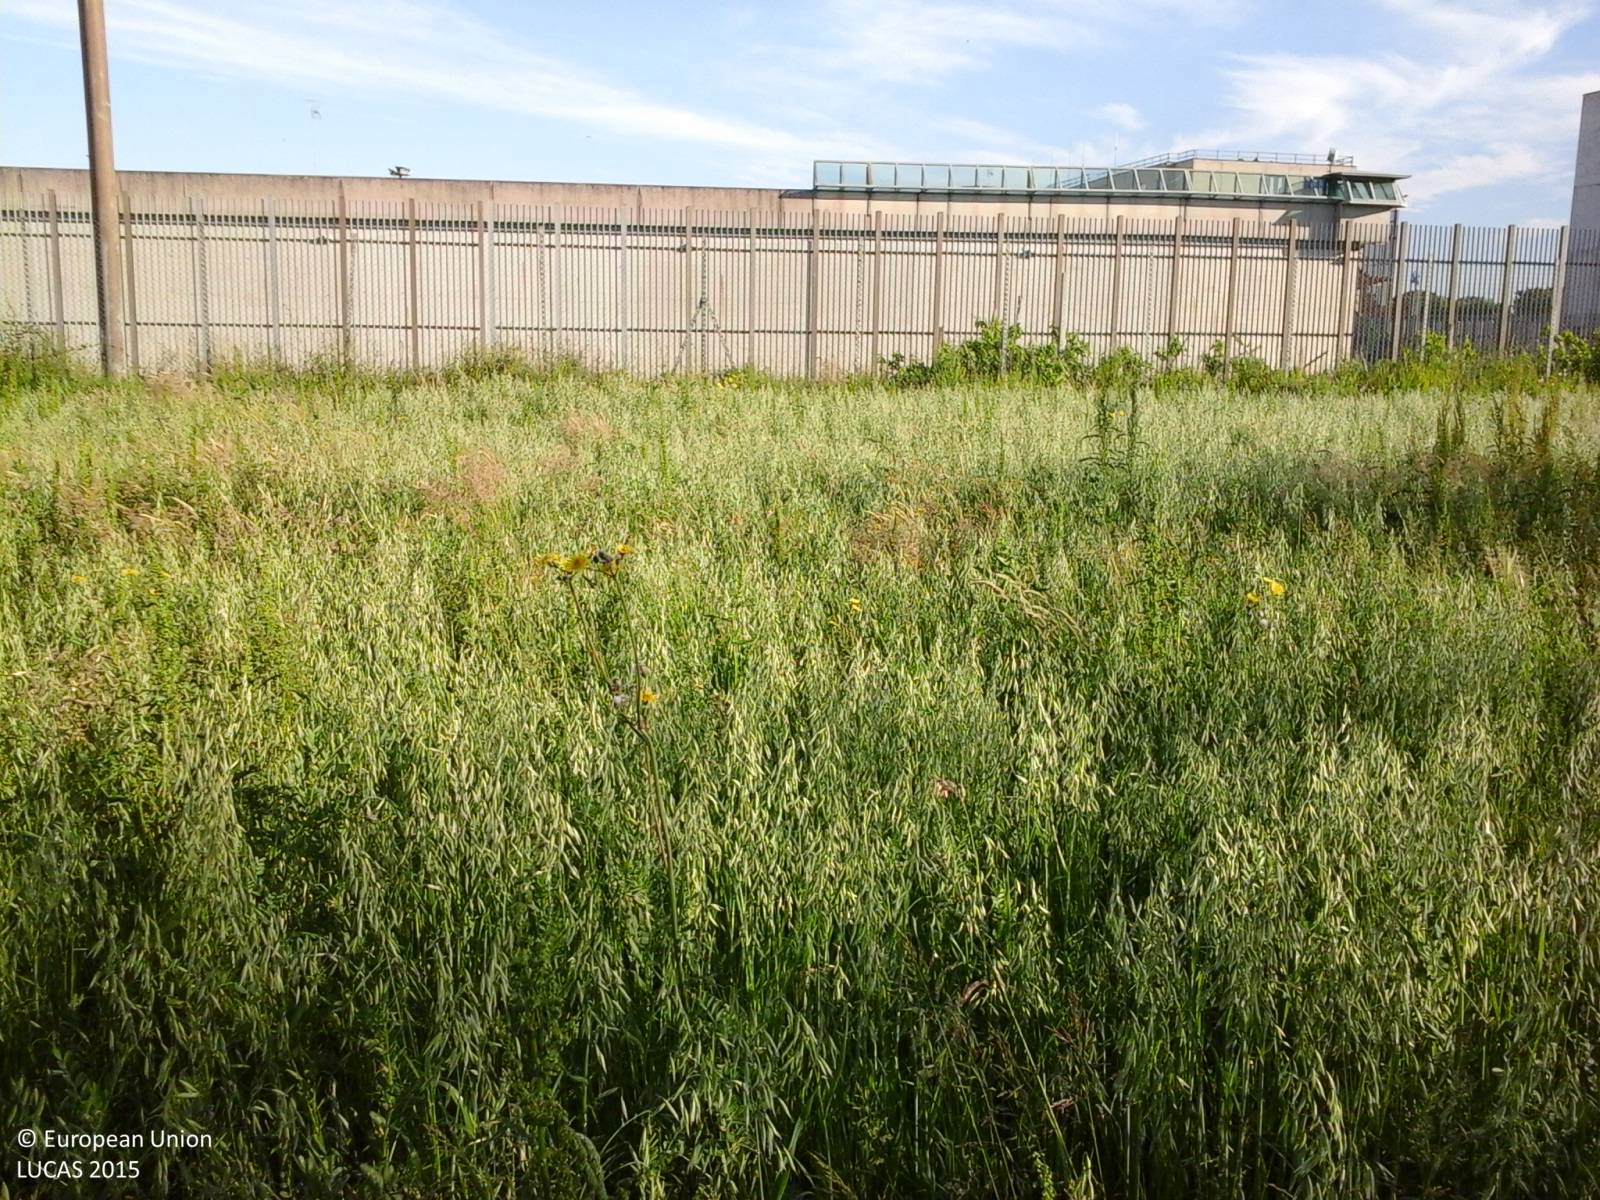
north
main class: Grassland
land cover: Grassland without tree/shrub cover
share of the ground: > 75 %
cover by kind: herbaceous plants 100 %
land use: Agriculture (excluding fallow land and kitchen gardens)
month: May
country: IT
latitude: 42.4517
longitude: 12.0964
